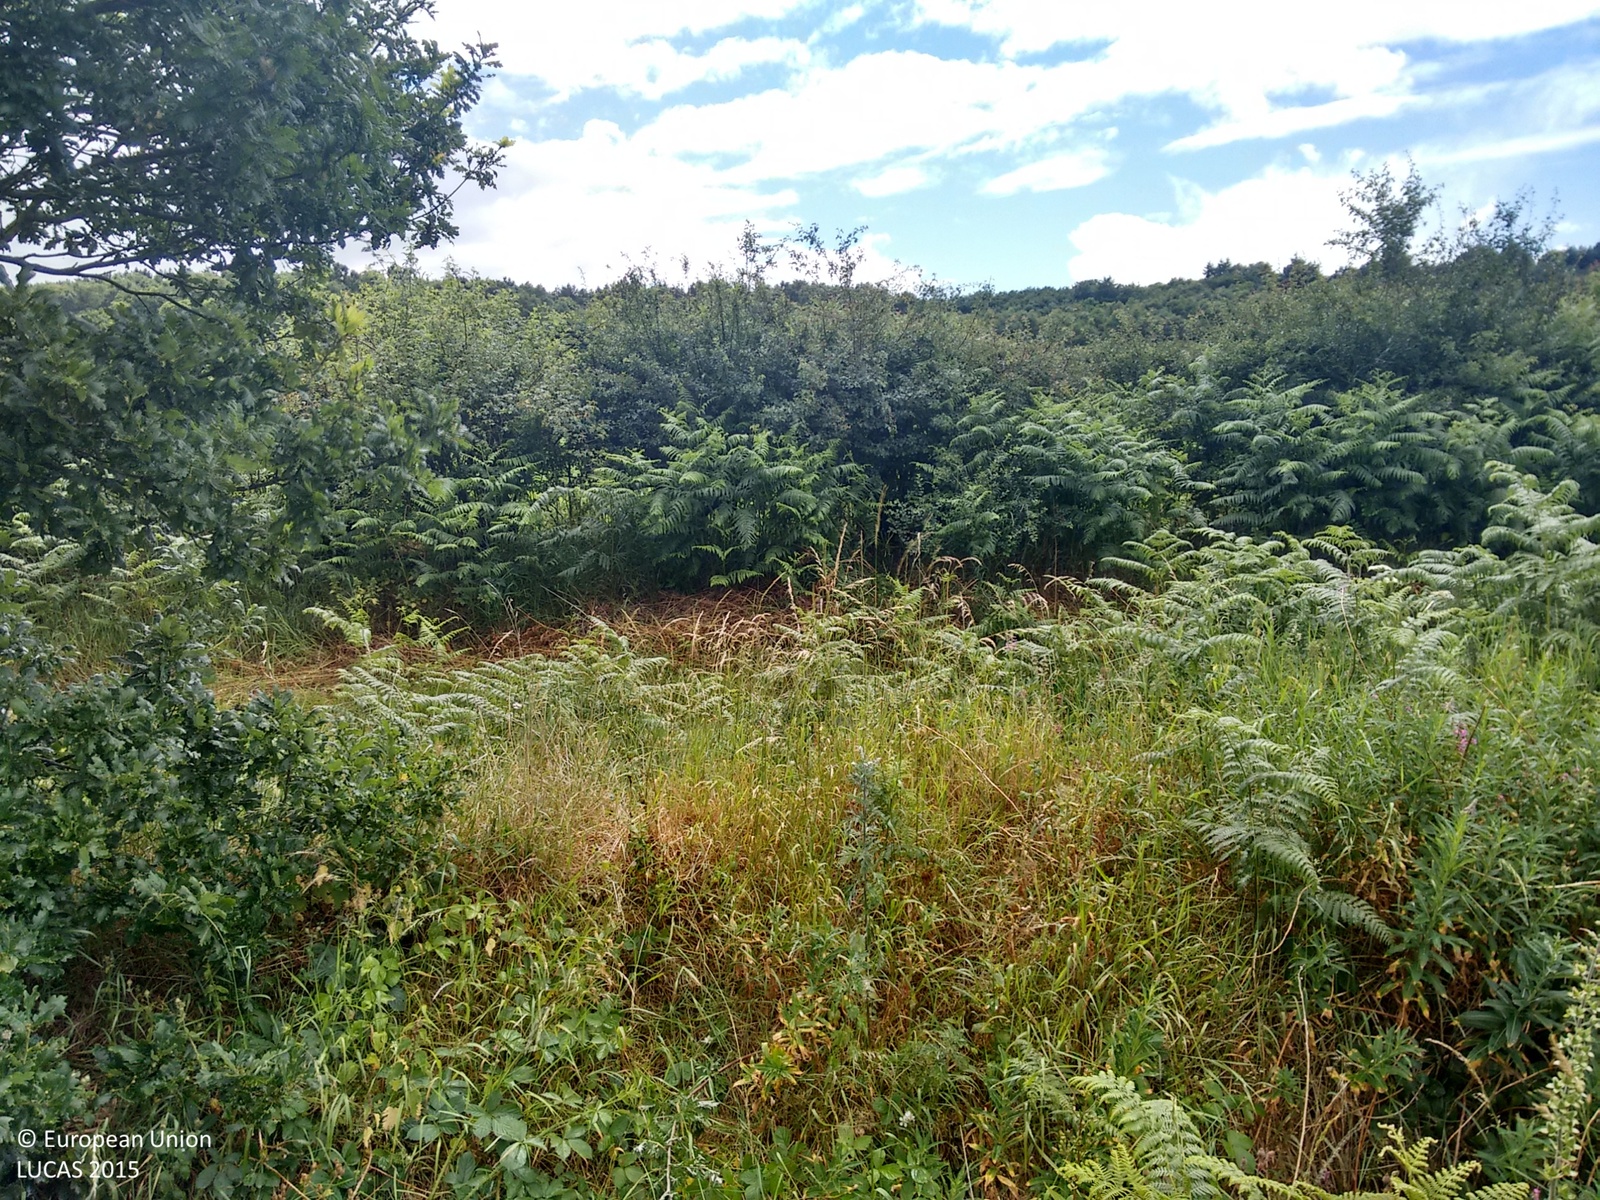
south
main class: Cropland
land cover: Other fibre and oleaginous crops
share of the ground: > 75 %
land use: Agriculture (excluding fallow land and kitchen gardens)
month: July
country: GB
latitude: 53.4270
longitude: -0.9843
